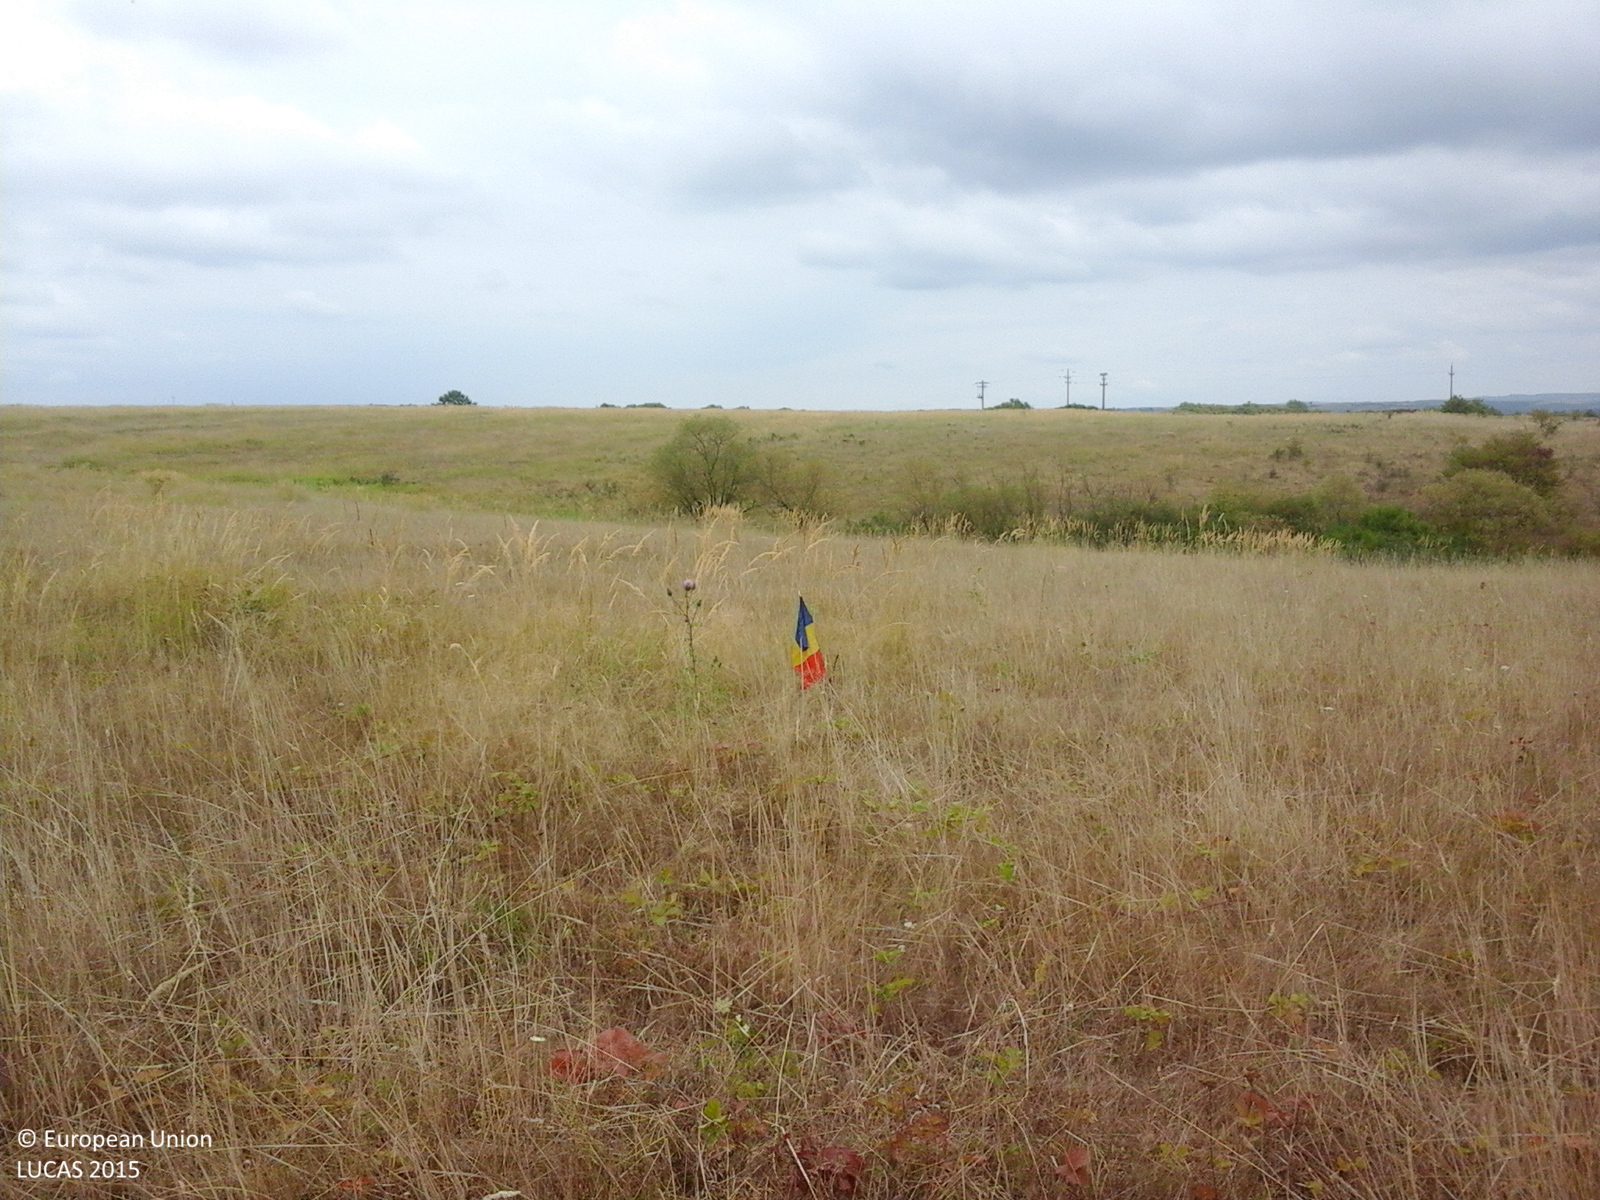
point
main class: Grassland
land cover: Grassland without tree/shrub cover
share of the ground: > 75 %
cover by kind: herbaceous plants 100 %
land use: Agriculture (excluding fallow land and kitchen gardens)
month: August
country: RO
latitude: 45.8922
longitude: 21.8307
